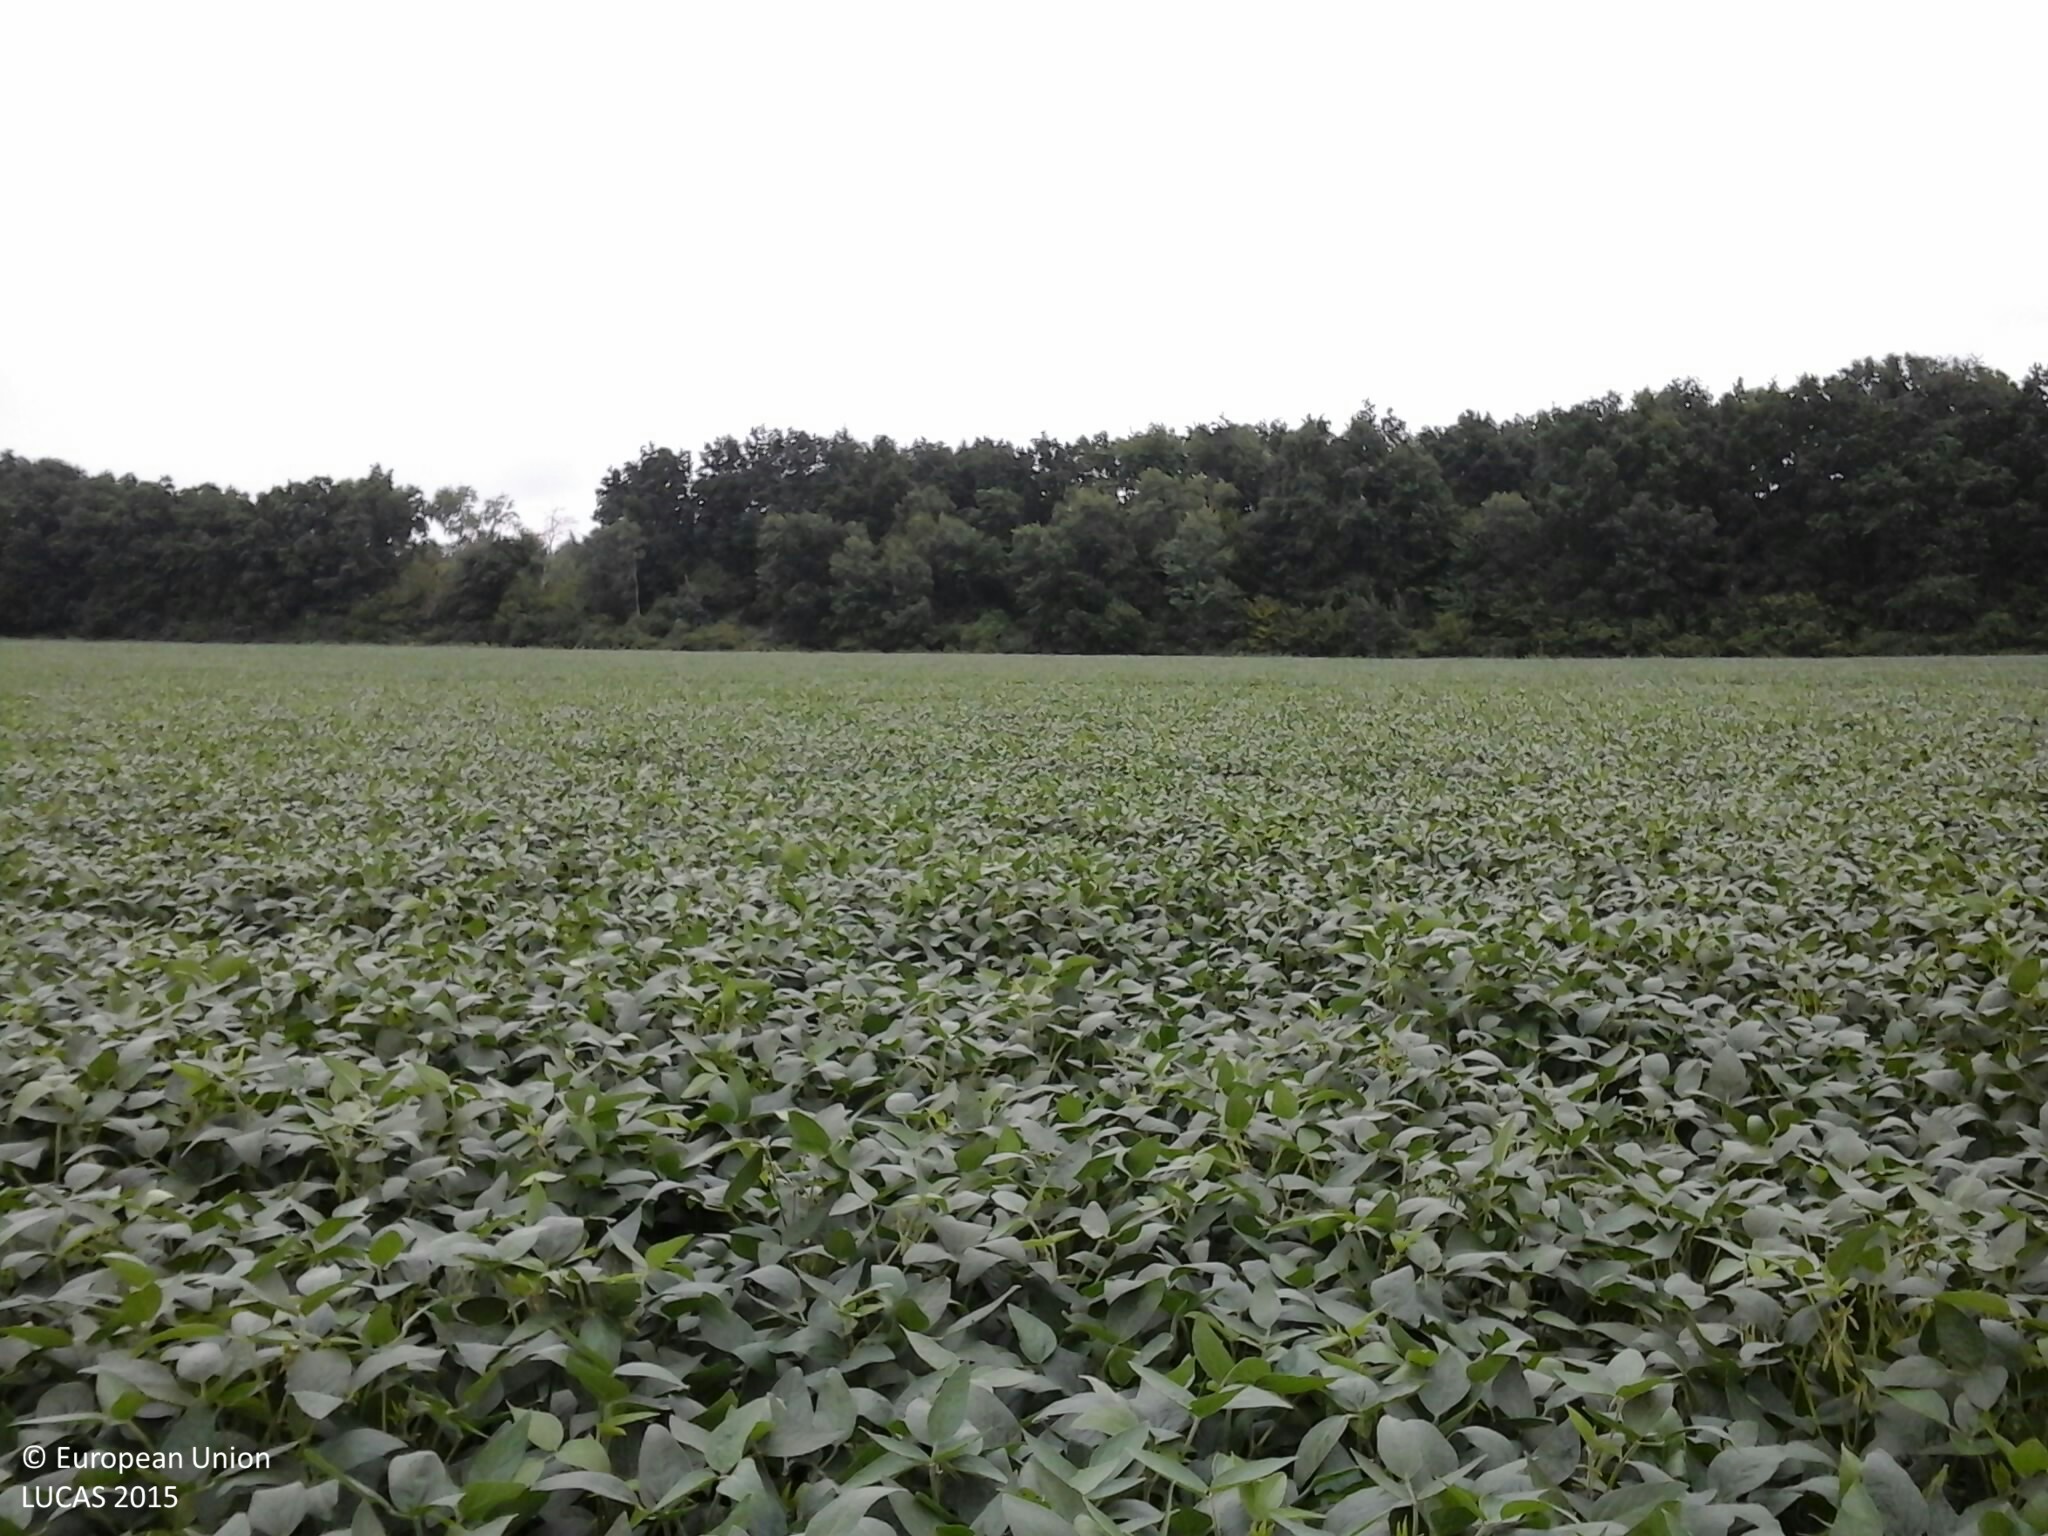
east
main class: Cropland
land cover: Soya
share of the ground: > 75 %
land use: Agriculture (excluding fallow land and kitchen gardens)
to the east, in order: Soya; Broadleaved woodland; Spruce dominated coniferous woodland; Broadleaved woodland
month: July
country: HU
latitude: 46.7180
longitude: 16.4250
